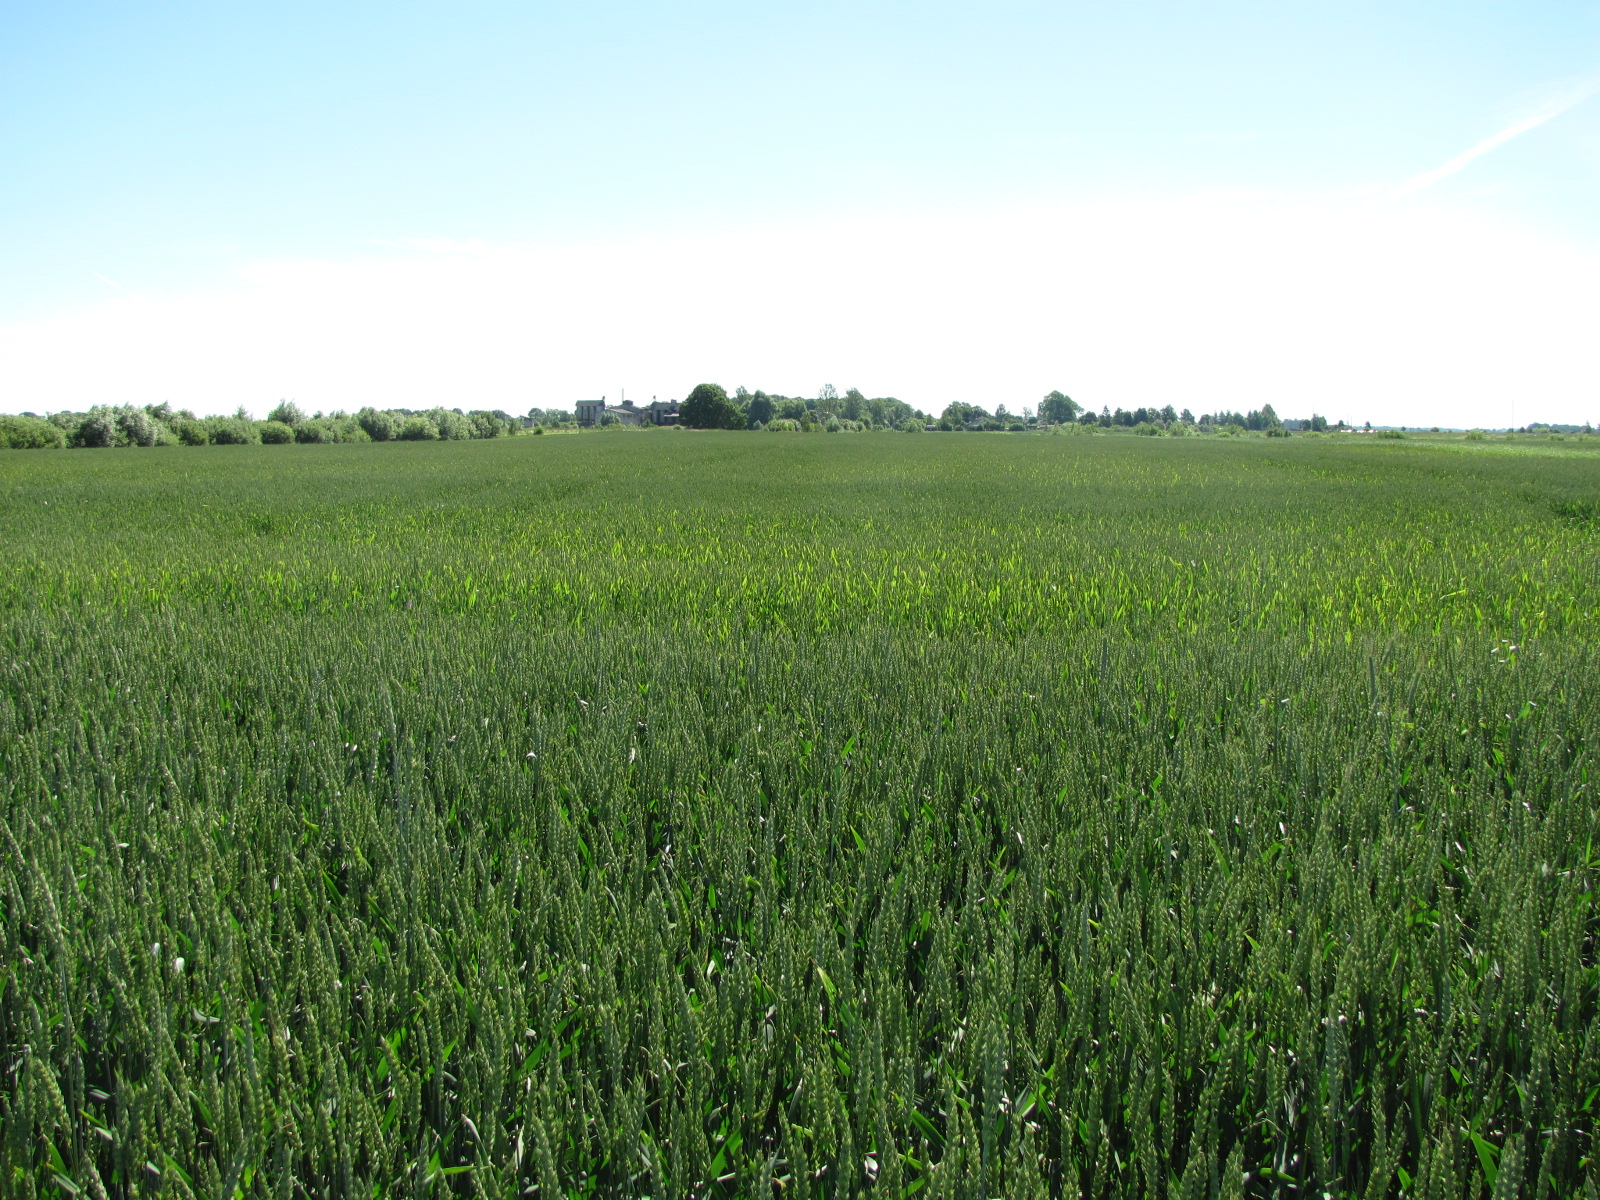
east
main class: Cropland
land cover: Common wheat
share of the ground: > 75 %
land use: Agriculture (excluding fallow land and kitchen gardens)
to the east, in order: Common wheat; Broadleaved woodland; Spontaneously vegetated surfaces; Paved roads, cycling and walking lanes; Grassland without tree/shrub cover
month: July
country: LV
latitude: 56.4964
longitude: 23.8072
